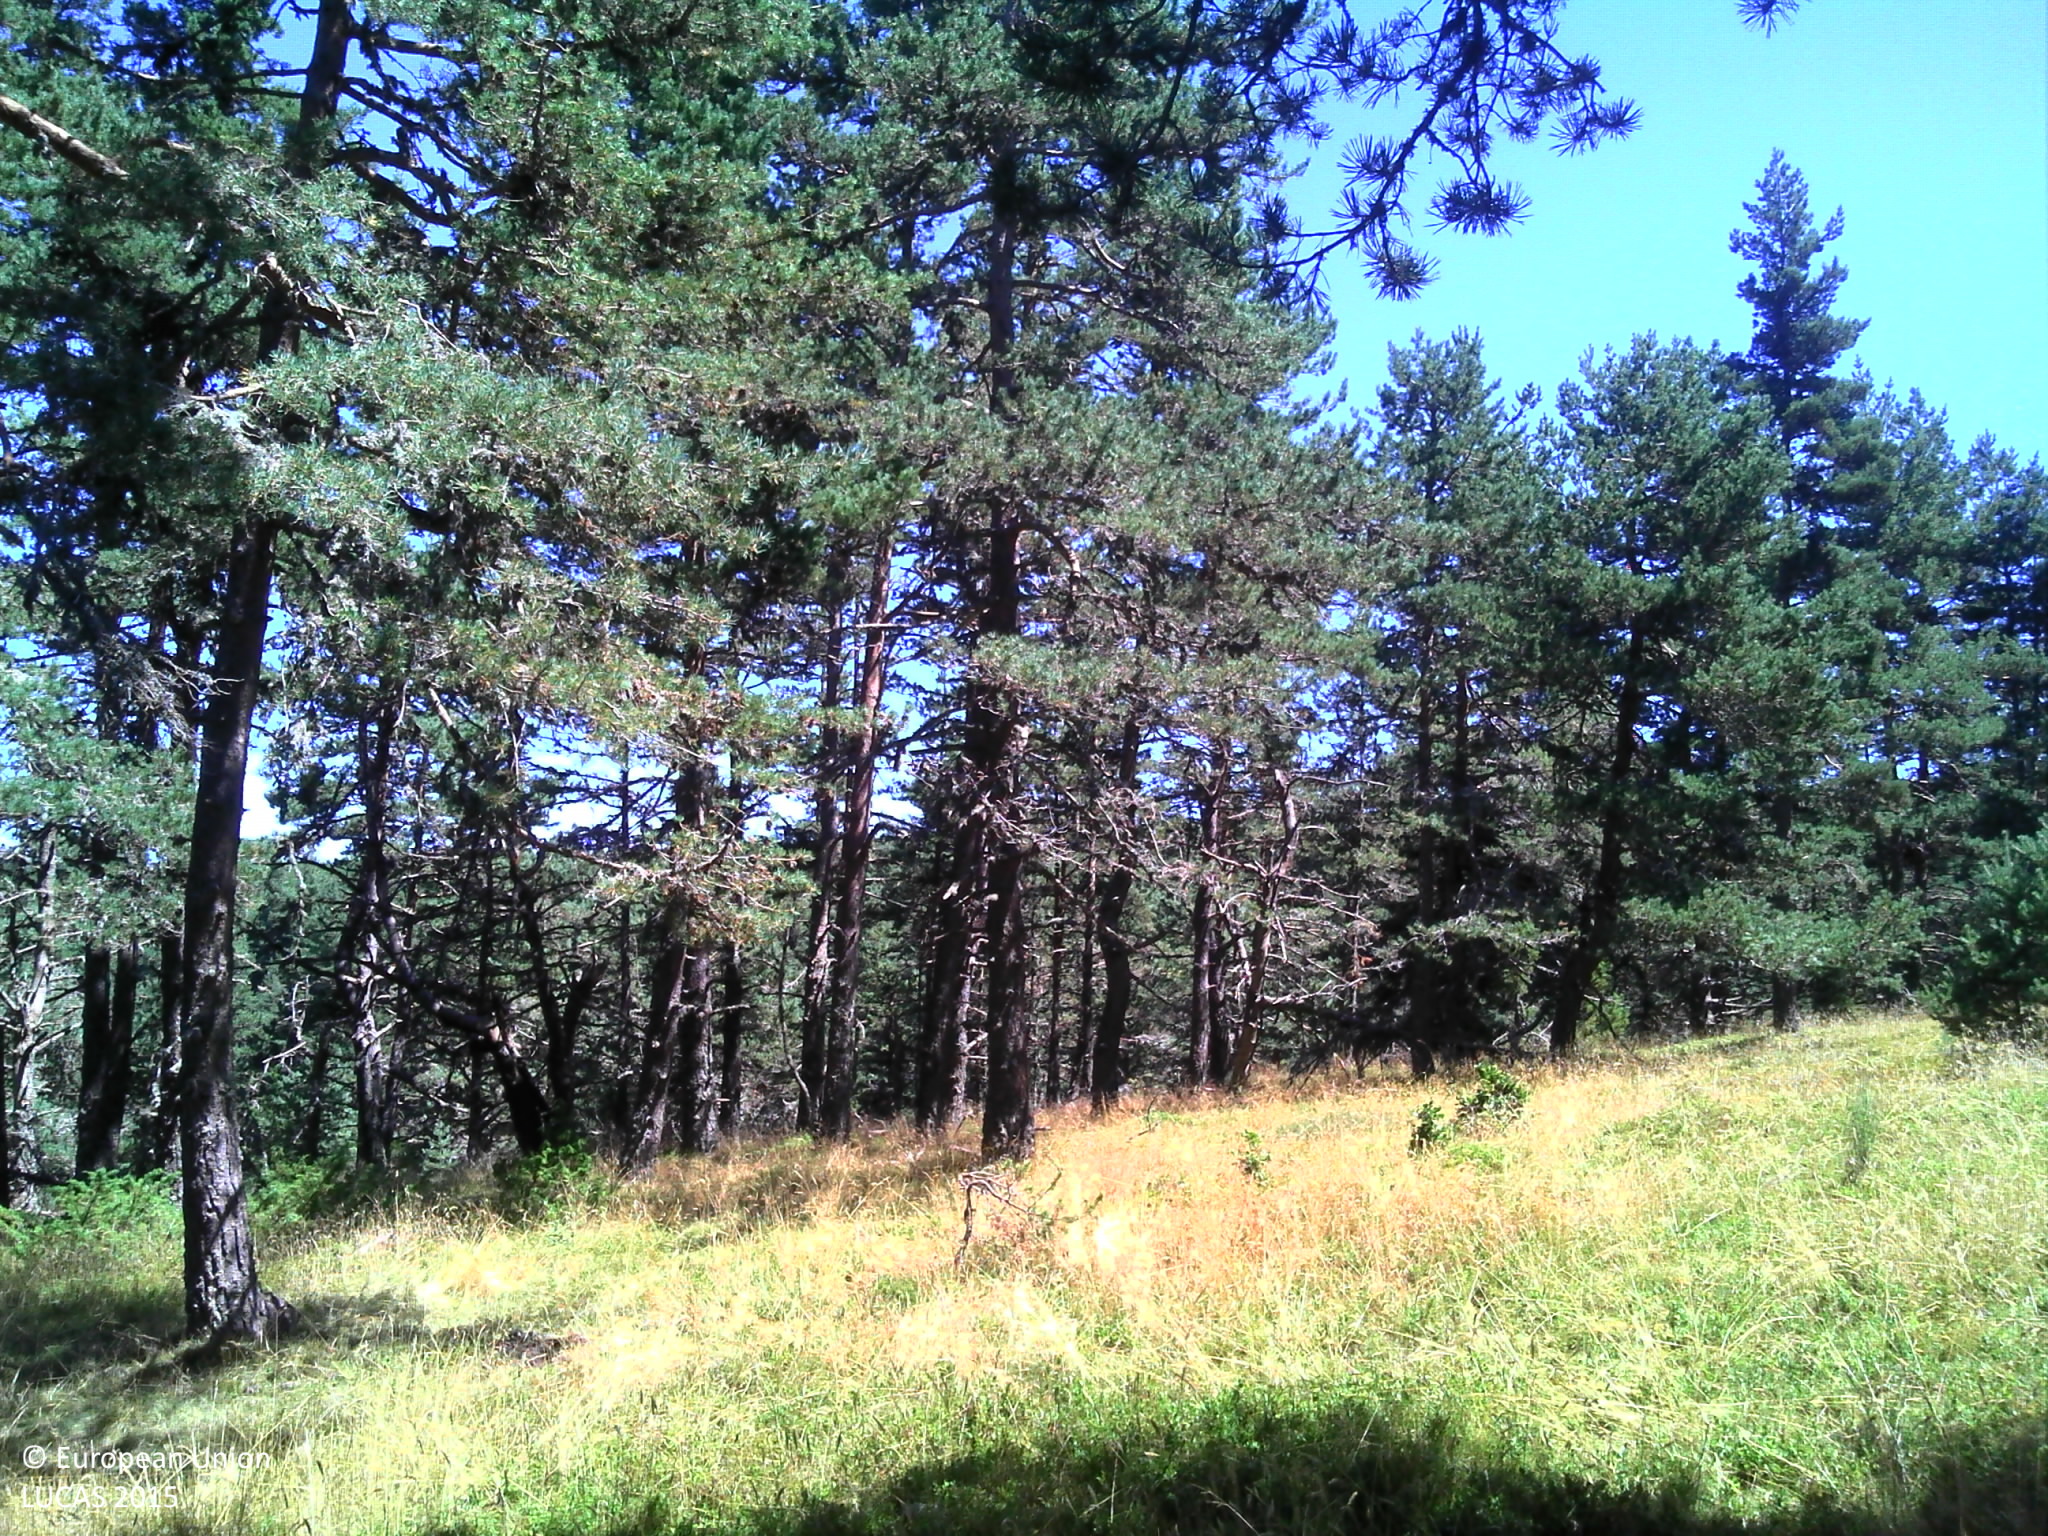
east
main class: Woodland
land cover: Pine dominated coniferous woodland
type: alpine coniferous forest
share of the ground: > 75 %
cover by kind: coniferous forest trees 95 %, broadleaved forest trees 5 %
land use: Agriculture (excluding fallow land and kitchen gardens)
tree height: > 5 m
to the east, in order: Pine dominated coniferous woodland; Grassland without tree/shrub cover; Rivers and streams; Pine dominated coniferous woodland; Grassland without tree/shrub cover; Pine dominated coniferous woodland; Fences; Spruce dominated coniferous woodland
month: August
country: FR
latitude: 44.6733
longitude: 3.5335
